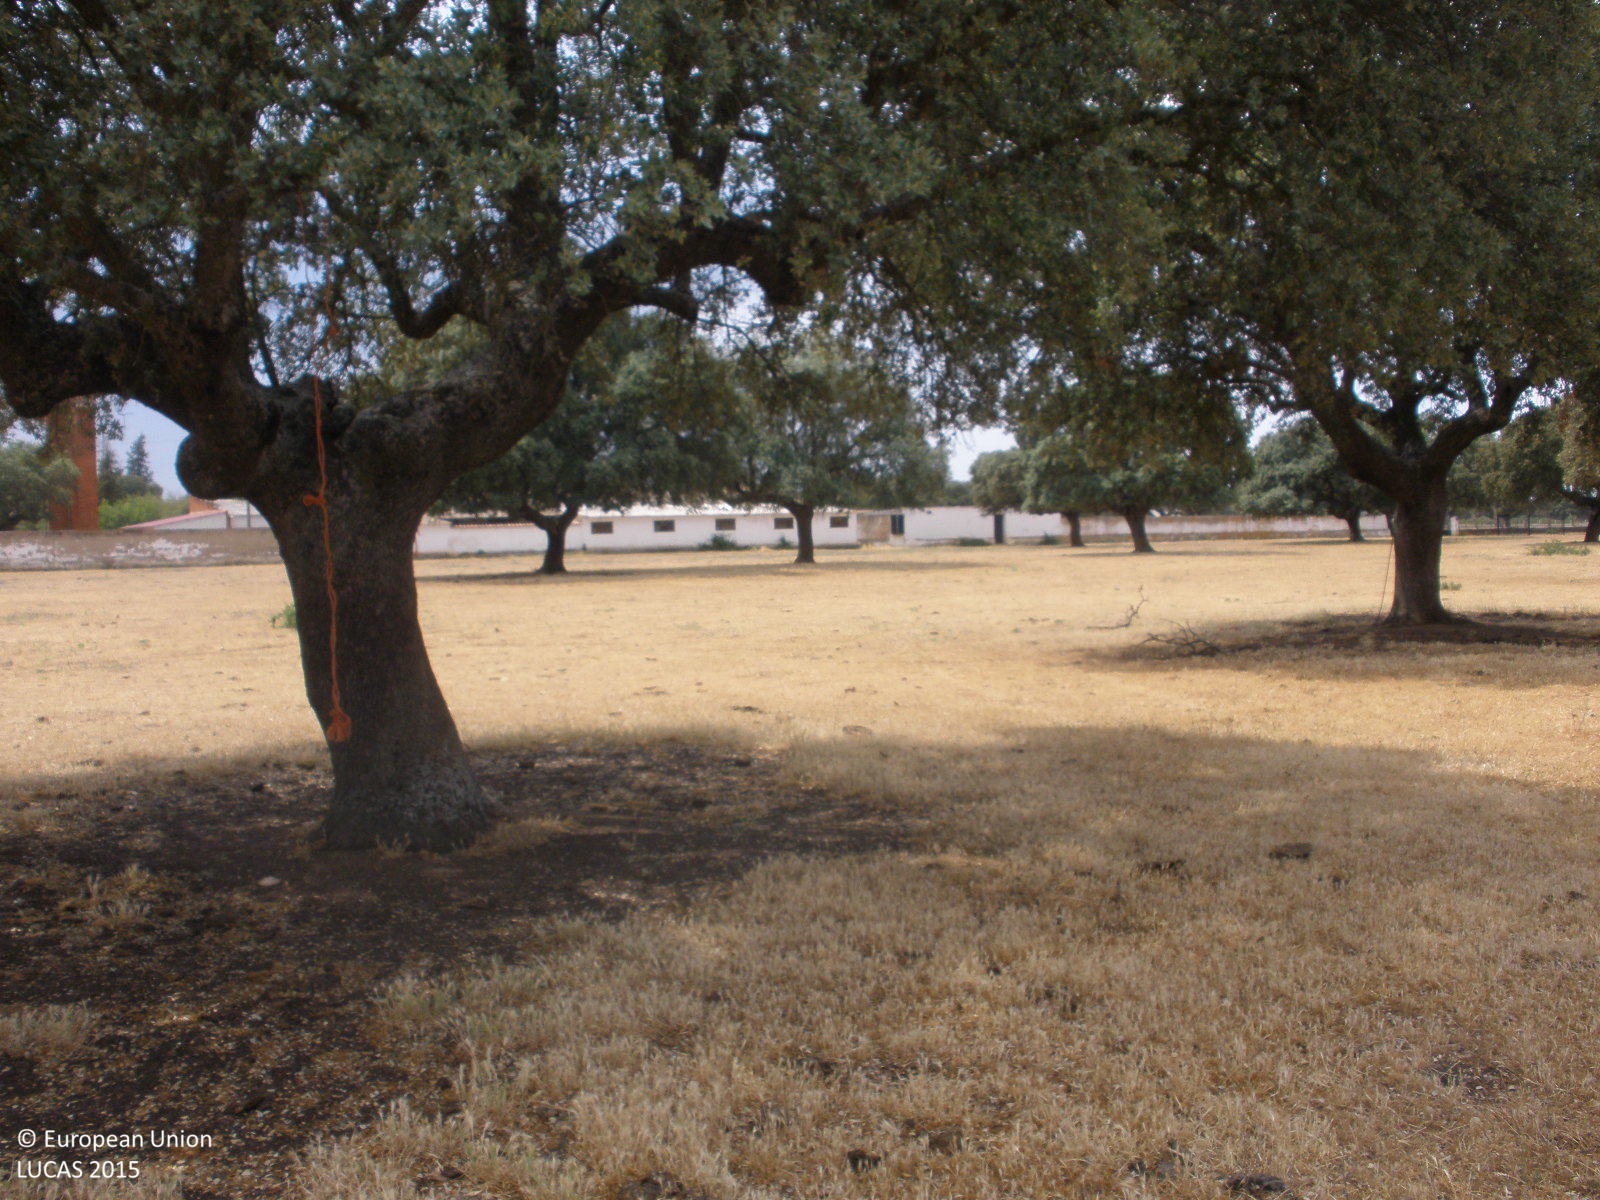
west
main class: Woodland
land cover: Broadleaved woodland
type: broadleaved evergreen forest
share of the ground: 10 - 25 %
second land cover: Grassland without tree/shrub cover
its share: > 75 %
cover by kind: herbaceous plants 90 %, broadleaved forest trees 10 %
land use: Forestry
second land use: Agriculture (excluding fallow land and kitchen gardens)
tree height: > 5 m
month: June
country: ES
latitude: 40.6723
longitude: -6.2325
